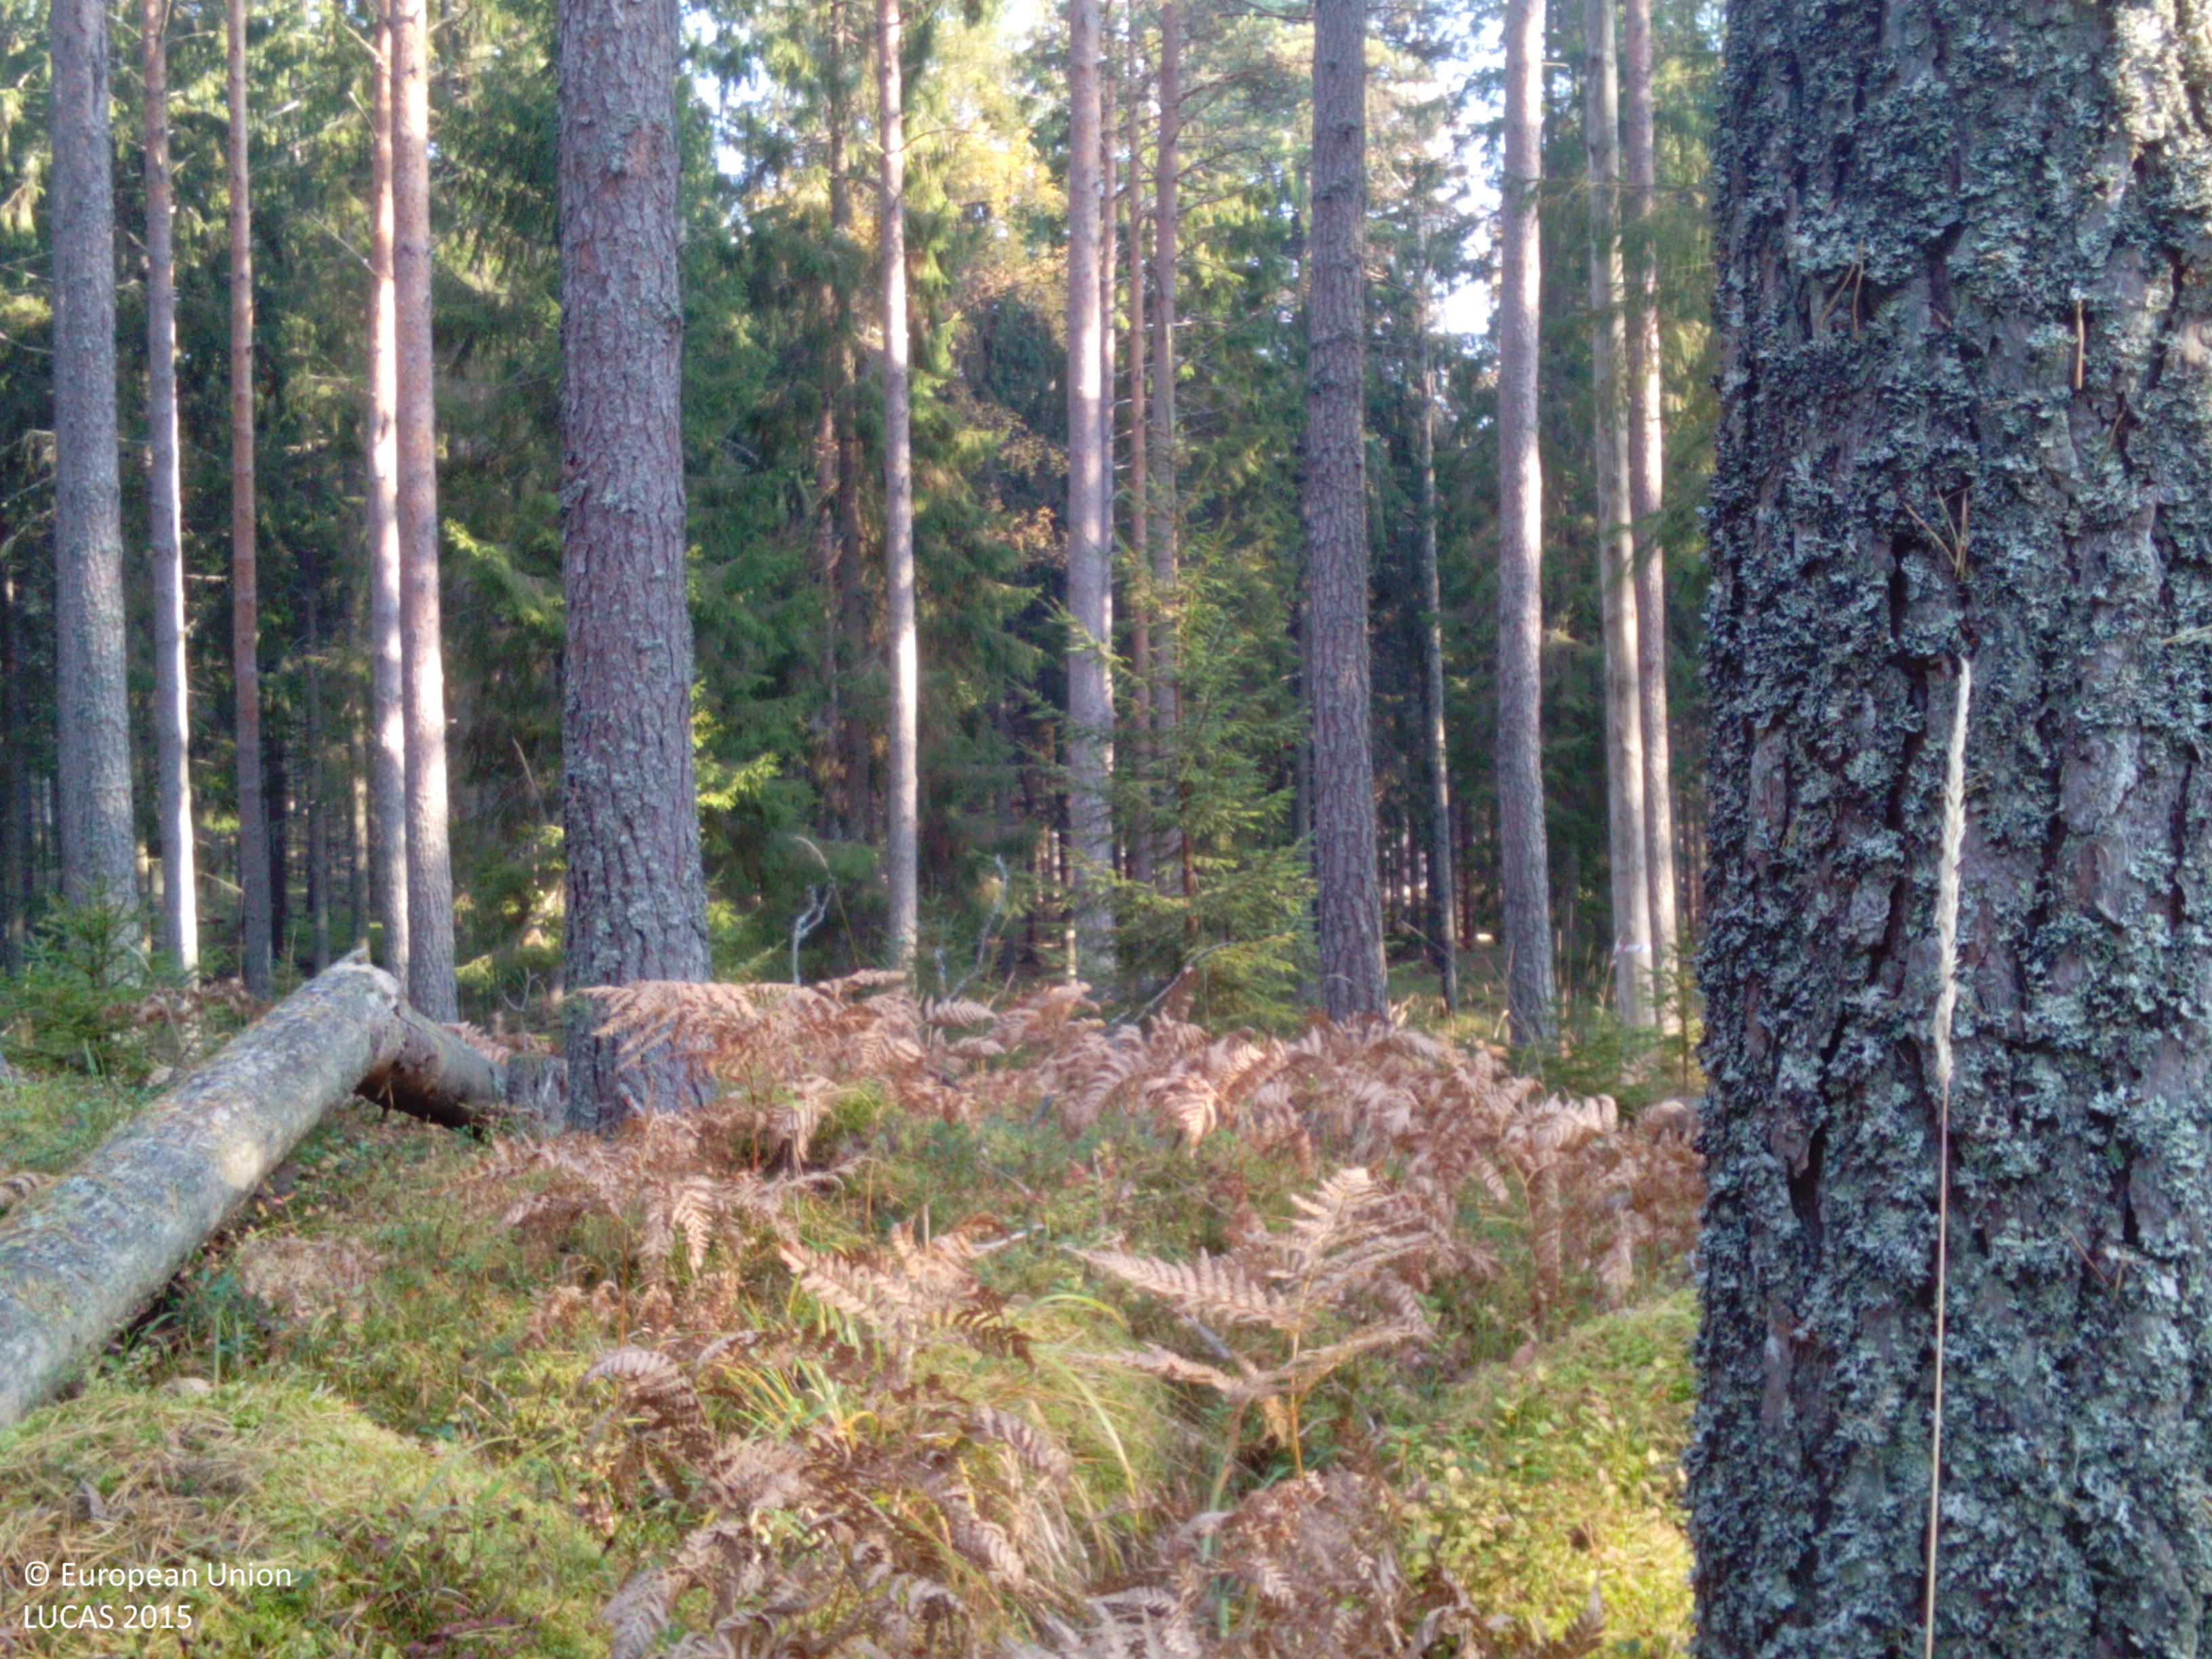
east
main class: Woodland
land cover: Other coniferous woodland
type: boreal forest
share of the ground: > 75 %
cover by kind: coniferous forest trees 85 %, herbaceous plants 10 %, lichens and mosses 5 %
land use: Forestry
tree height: > 5 m
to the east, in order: Other coniferous woodland; Spruce dominated coniferous woodland; Grassland without tree/shrub cover
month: October
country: SE
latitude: 58.8877
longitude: 16.2231
